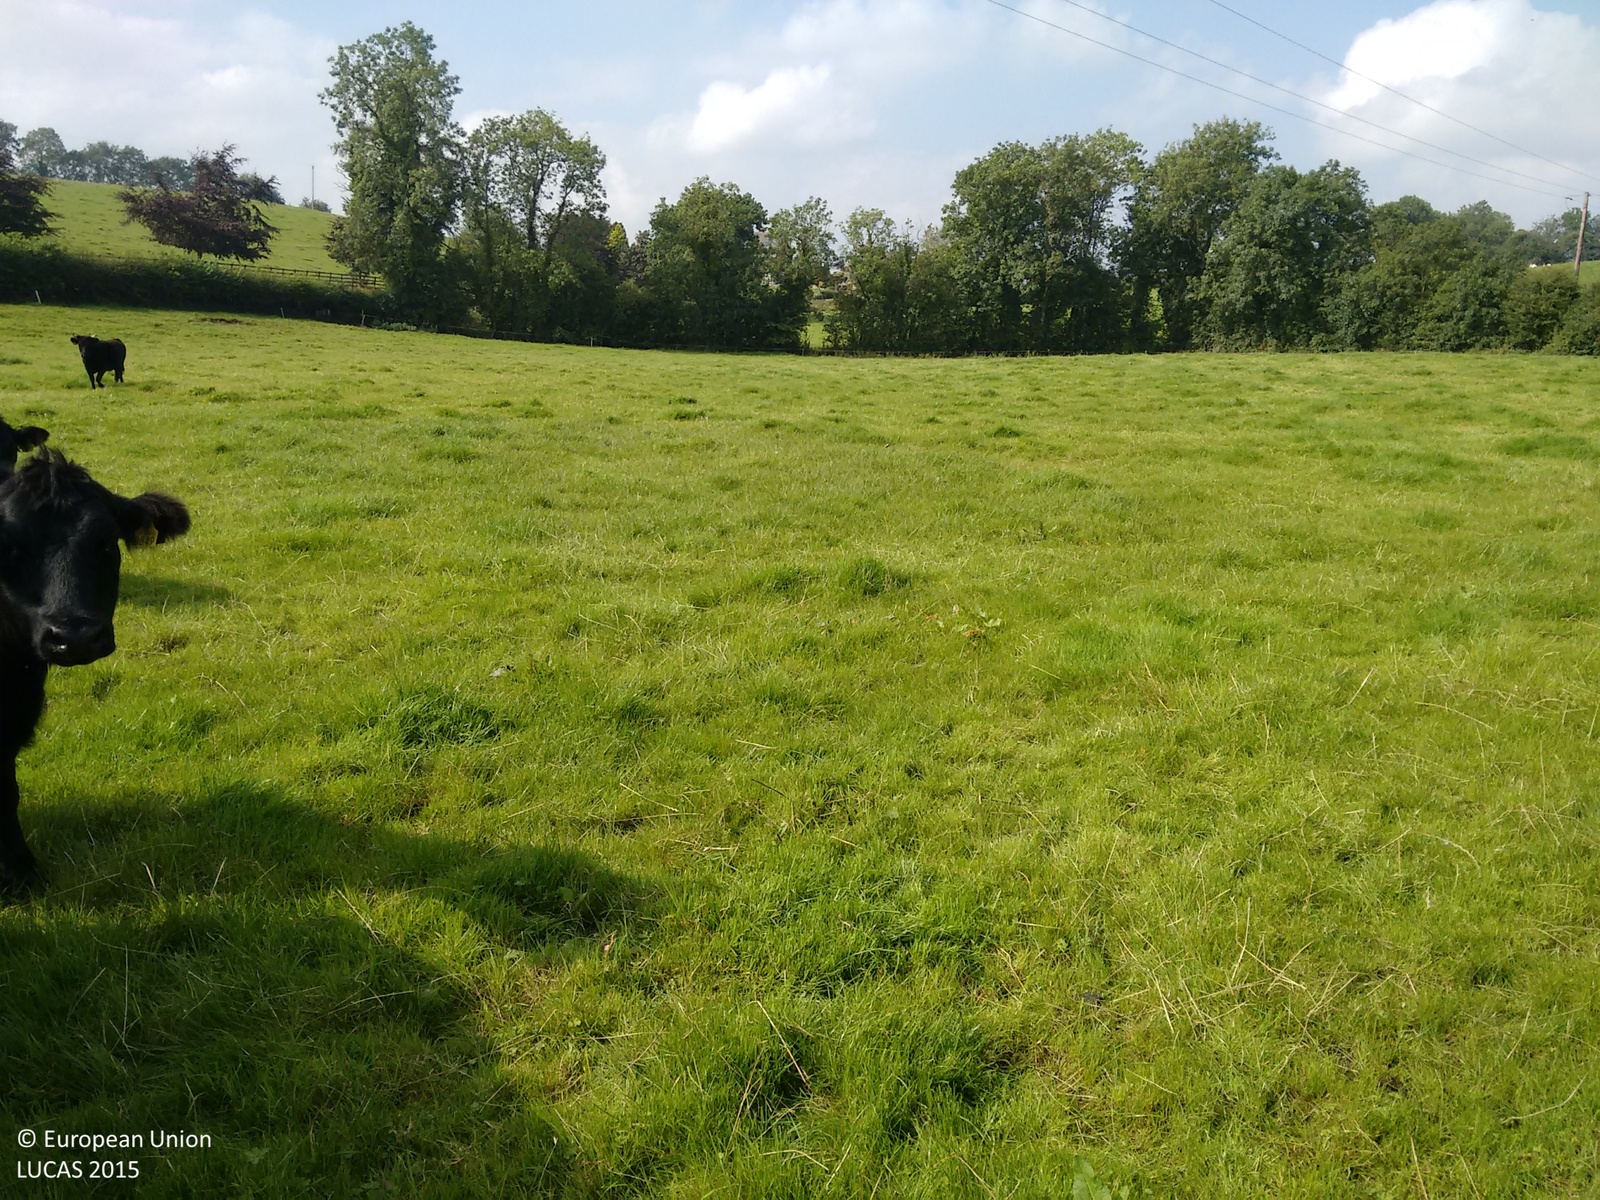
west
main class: Grassland
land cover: Grassland without tree/shrub cover
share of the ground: > 75 %
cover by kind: herbaceous plants 100 %
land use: Agriculture (excluding fallow land and kitchen gardens)
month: September
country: IE
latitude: 54.2690
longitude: -6.9840
